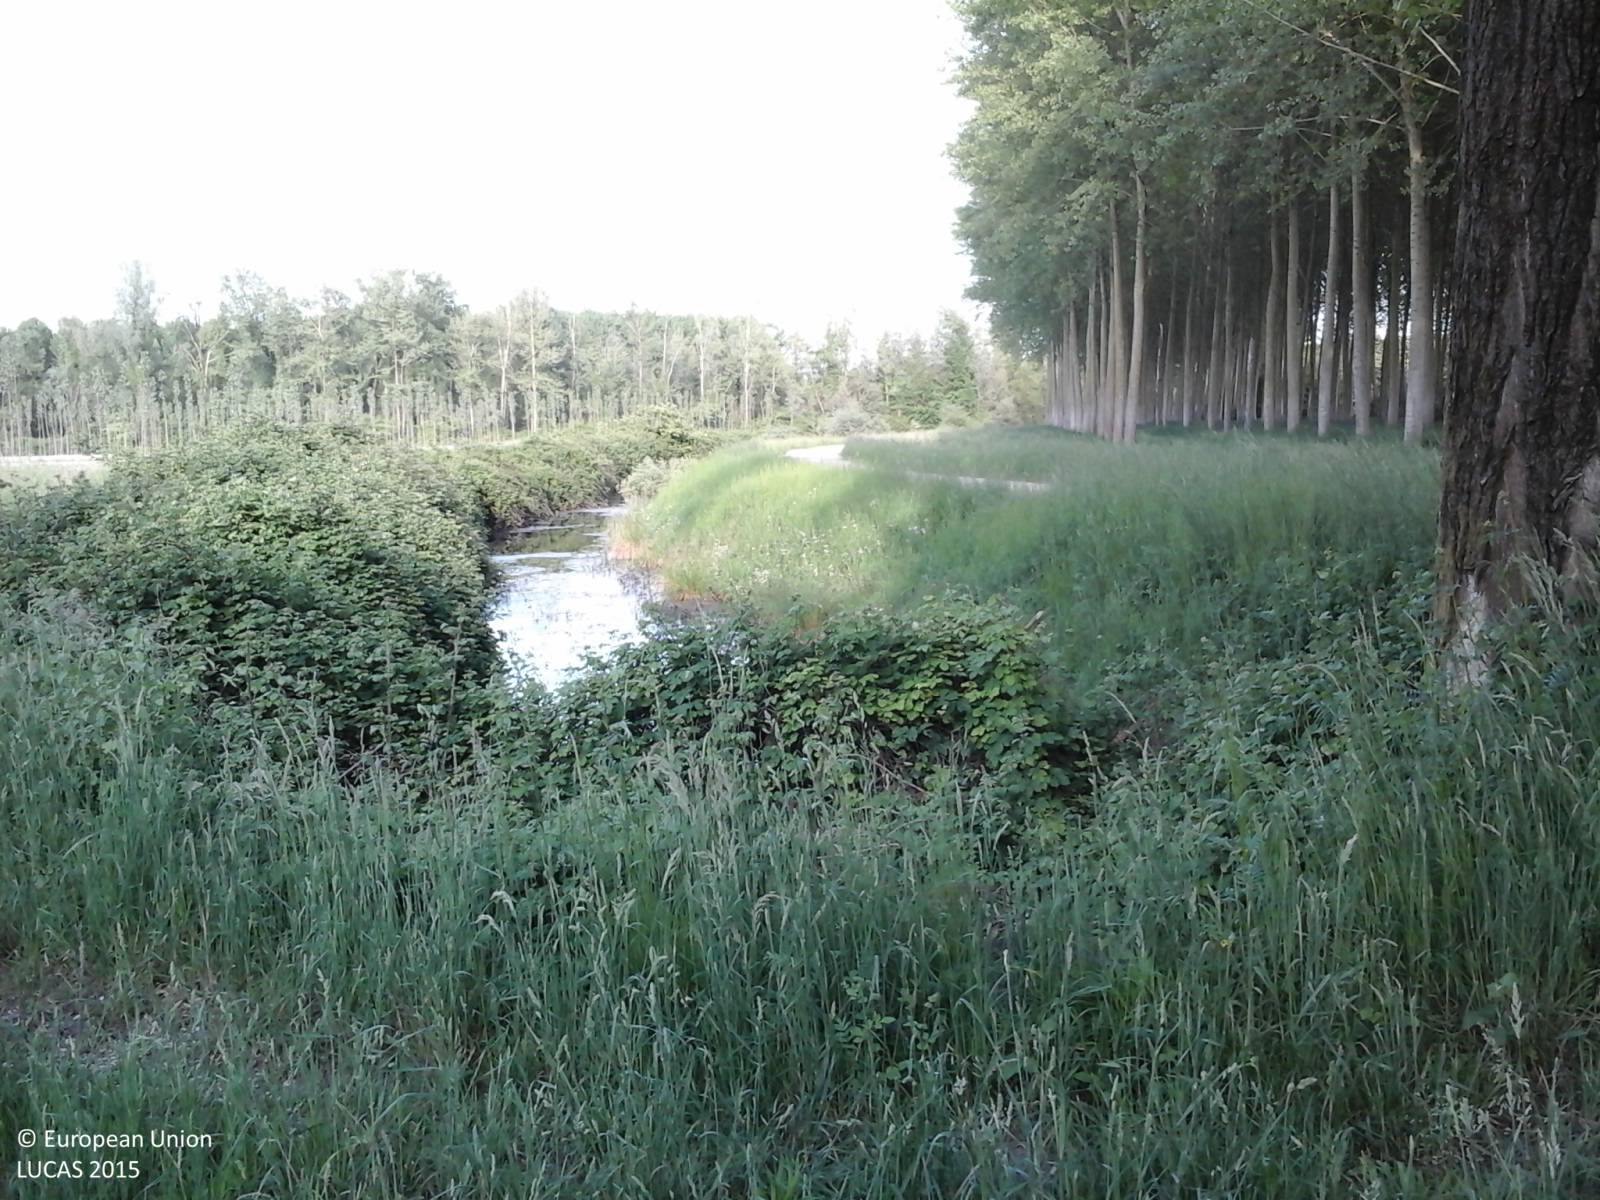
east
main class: Woodland
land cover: Broadleaved woodland
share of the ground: > 75 %
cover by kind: broadleaved forest trees 90 %, herbaceous plants 10 %
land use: Semi-natural and natural areas not in use
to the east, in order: Broadleaved woodland; Inland fresh running water; Grass margins; Paved roads, cycling and walking lanes; Grass margins; Single bushes/trees; Inland fresh running water; Shruby margins; Grass margins; Inland fresh running water; Tracks; Shrubland with sparse tree cover; Inland fresh running water; Broadleaved woodland
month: May
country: IT
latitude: 45.9119
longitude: 13.0259
